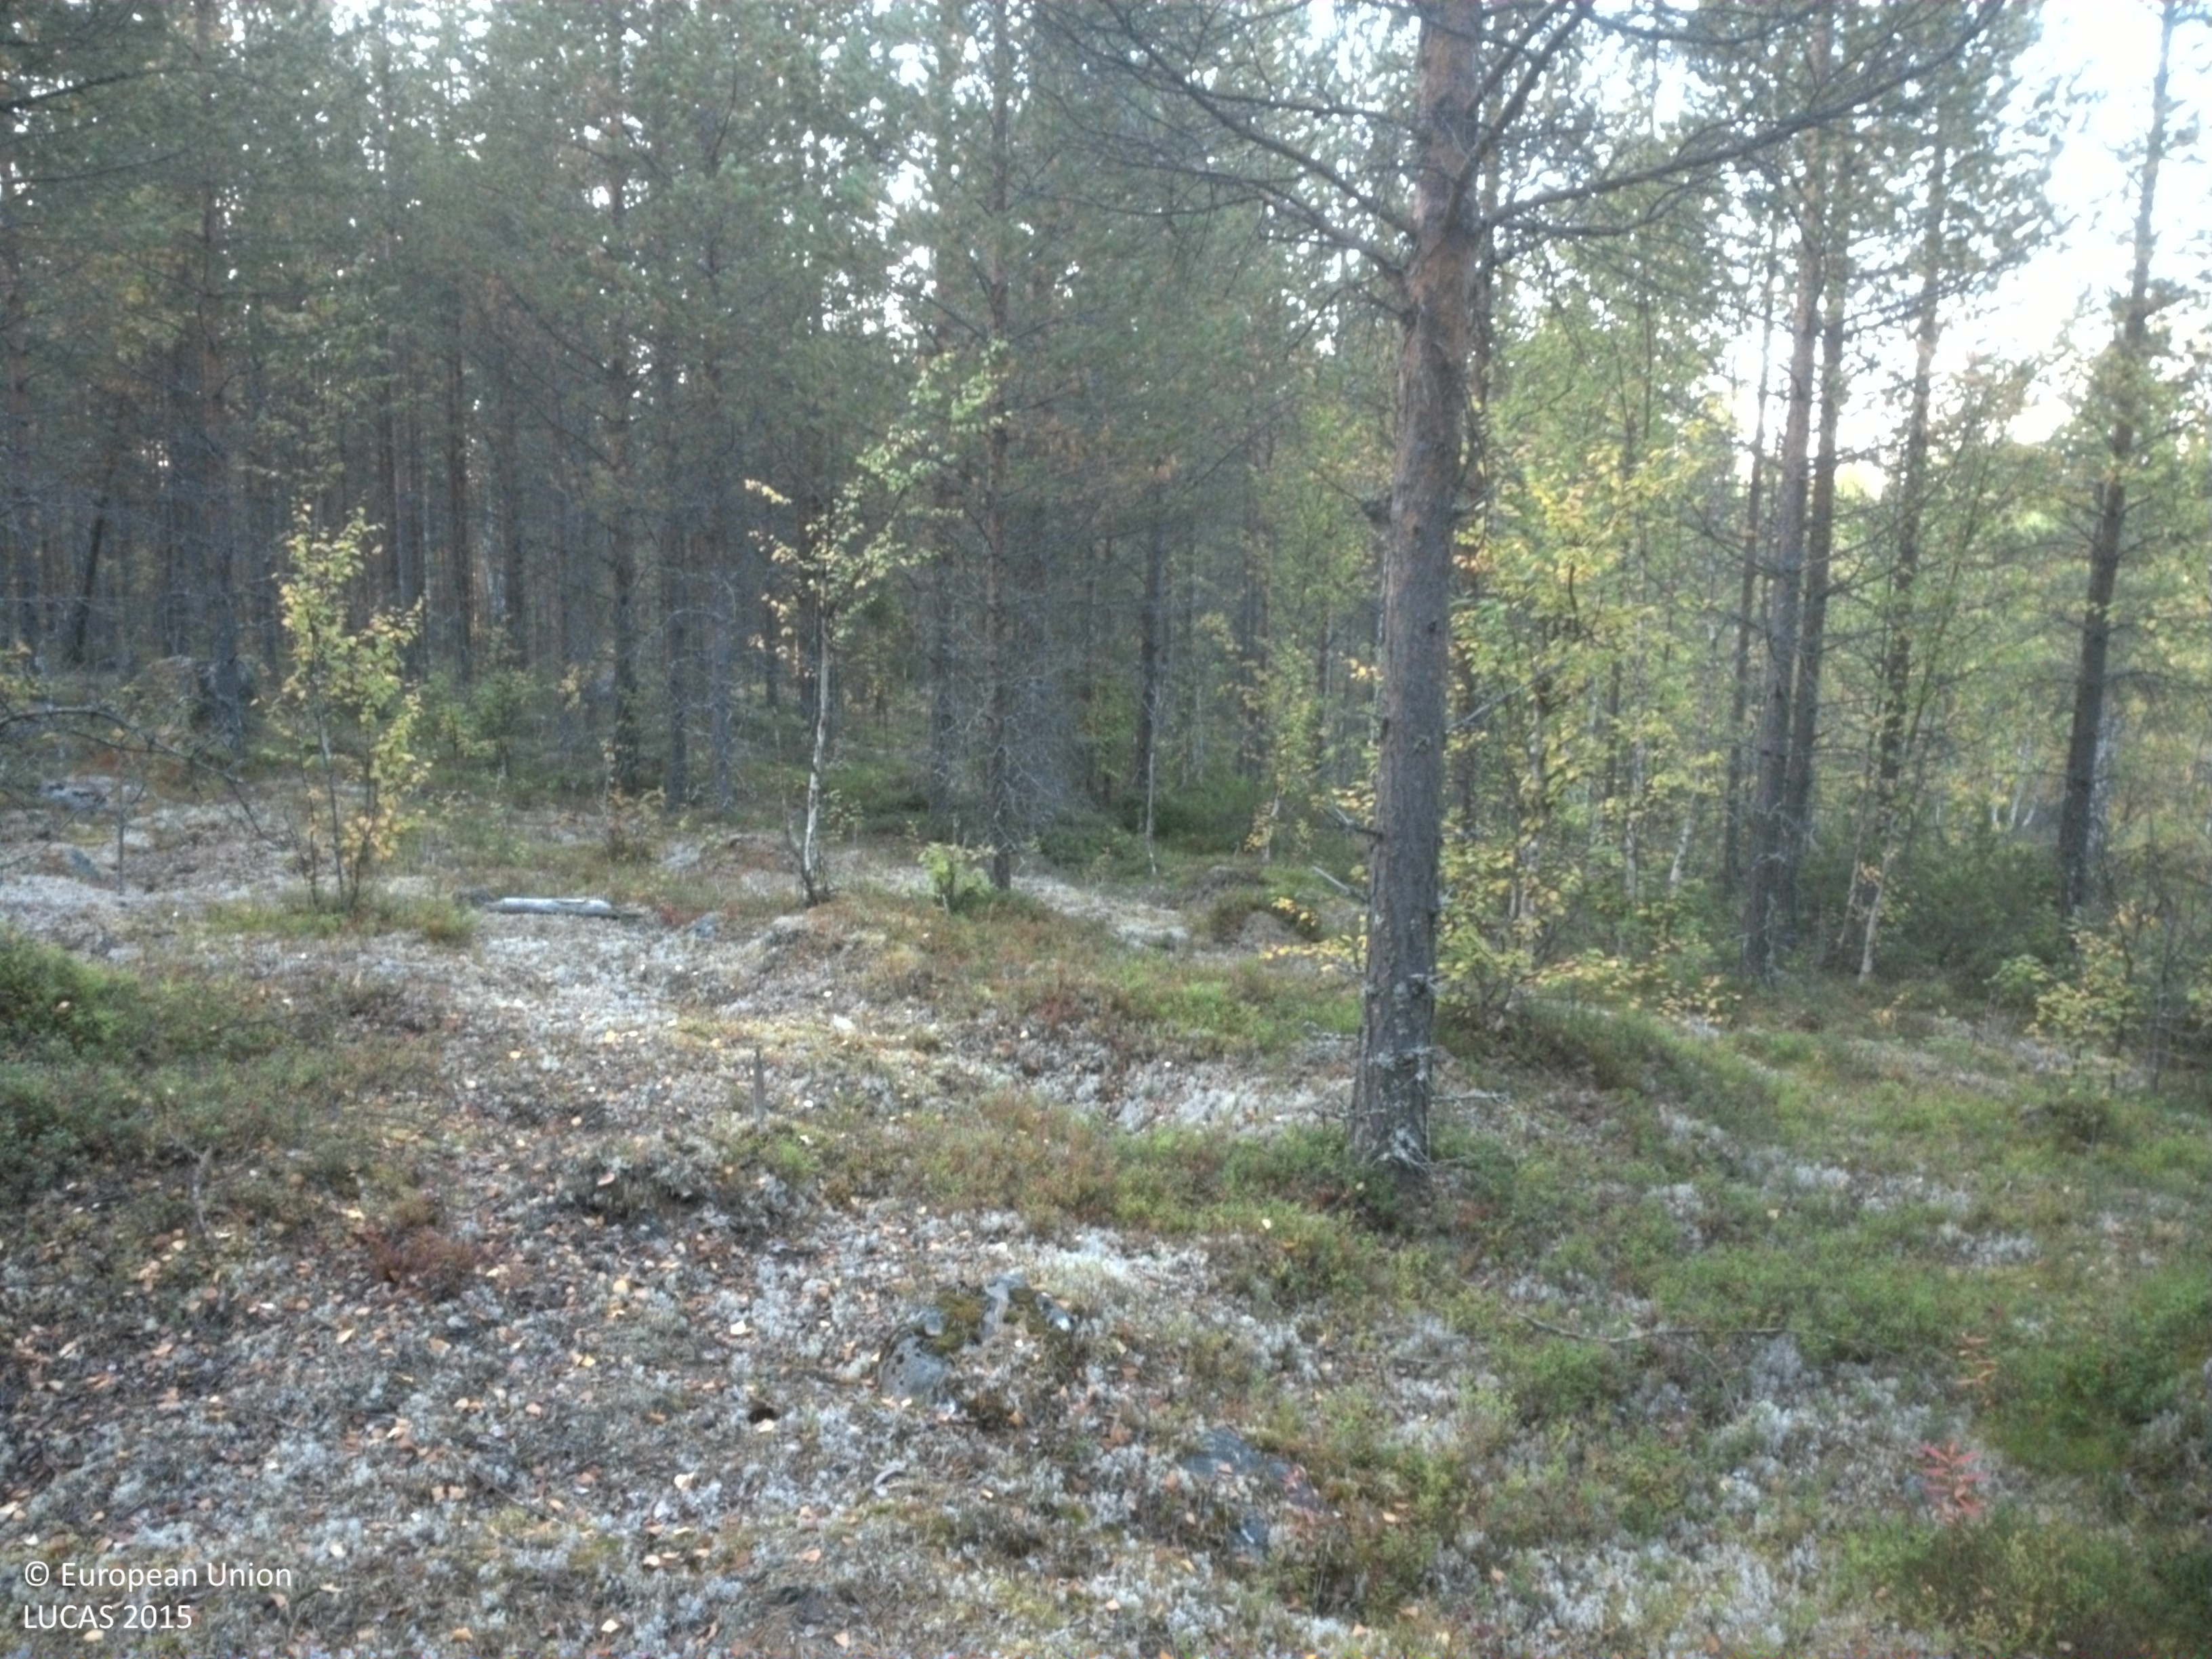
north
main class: Woodland
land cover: Pine dominated coniferous woodland
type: boreal forest
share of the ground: 25 - 50 %
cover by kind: coniferous forest trees 40 %, lichens and mosses 25 %, shrubs 20 %, herbaceous plants 10 %, broadleaved forest trees 5 %
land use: Forestry
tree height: > 5 m
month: September
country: SE
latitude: 64.4280
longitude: 20.0037
